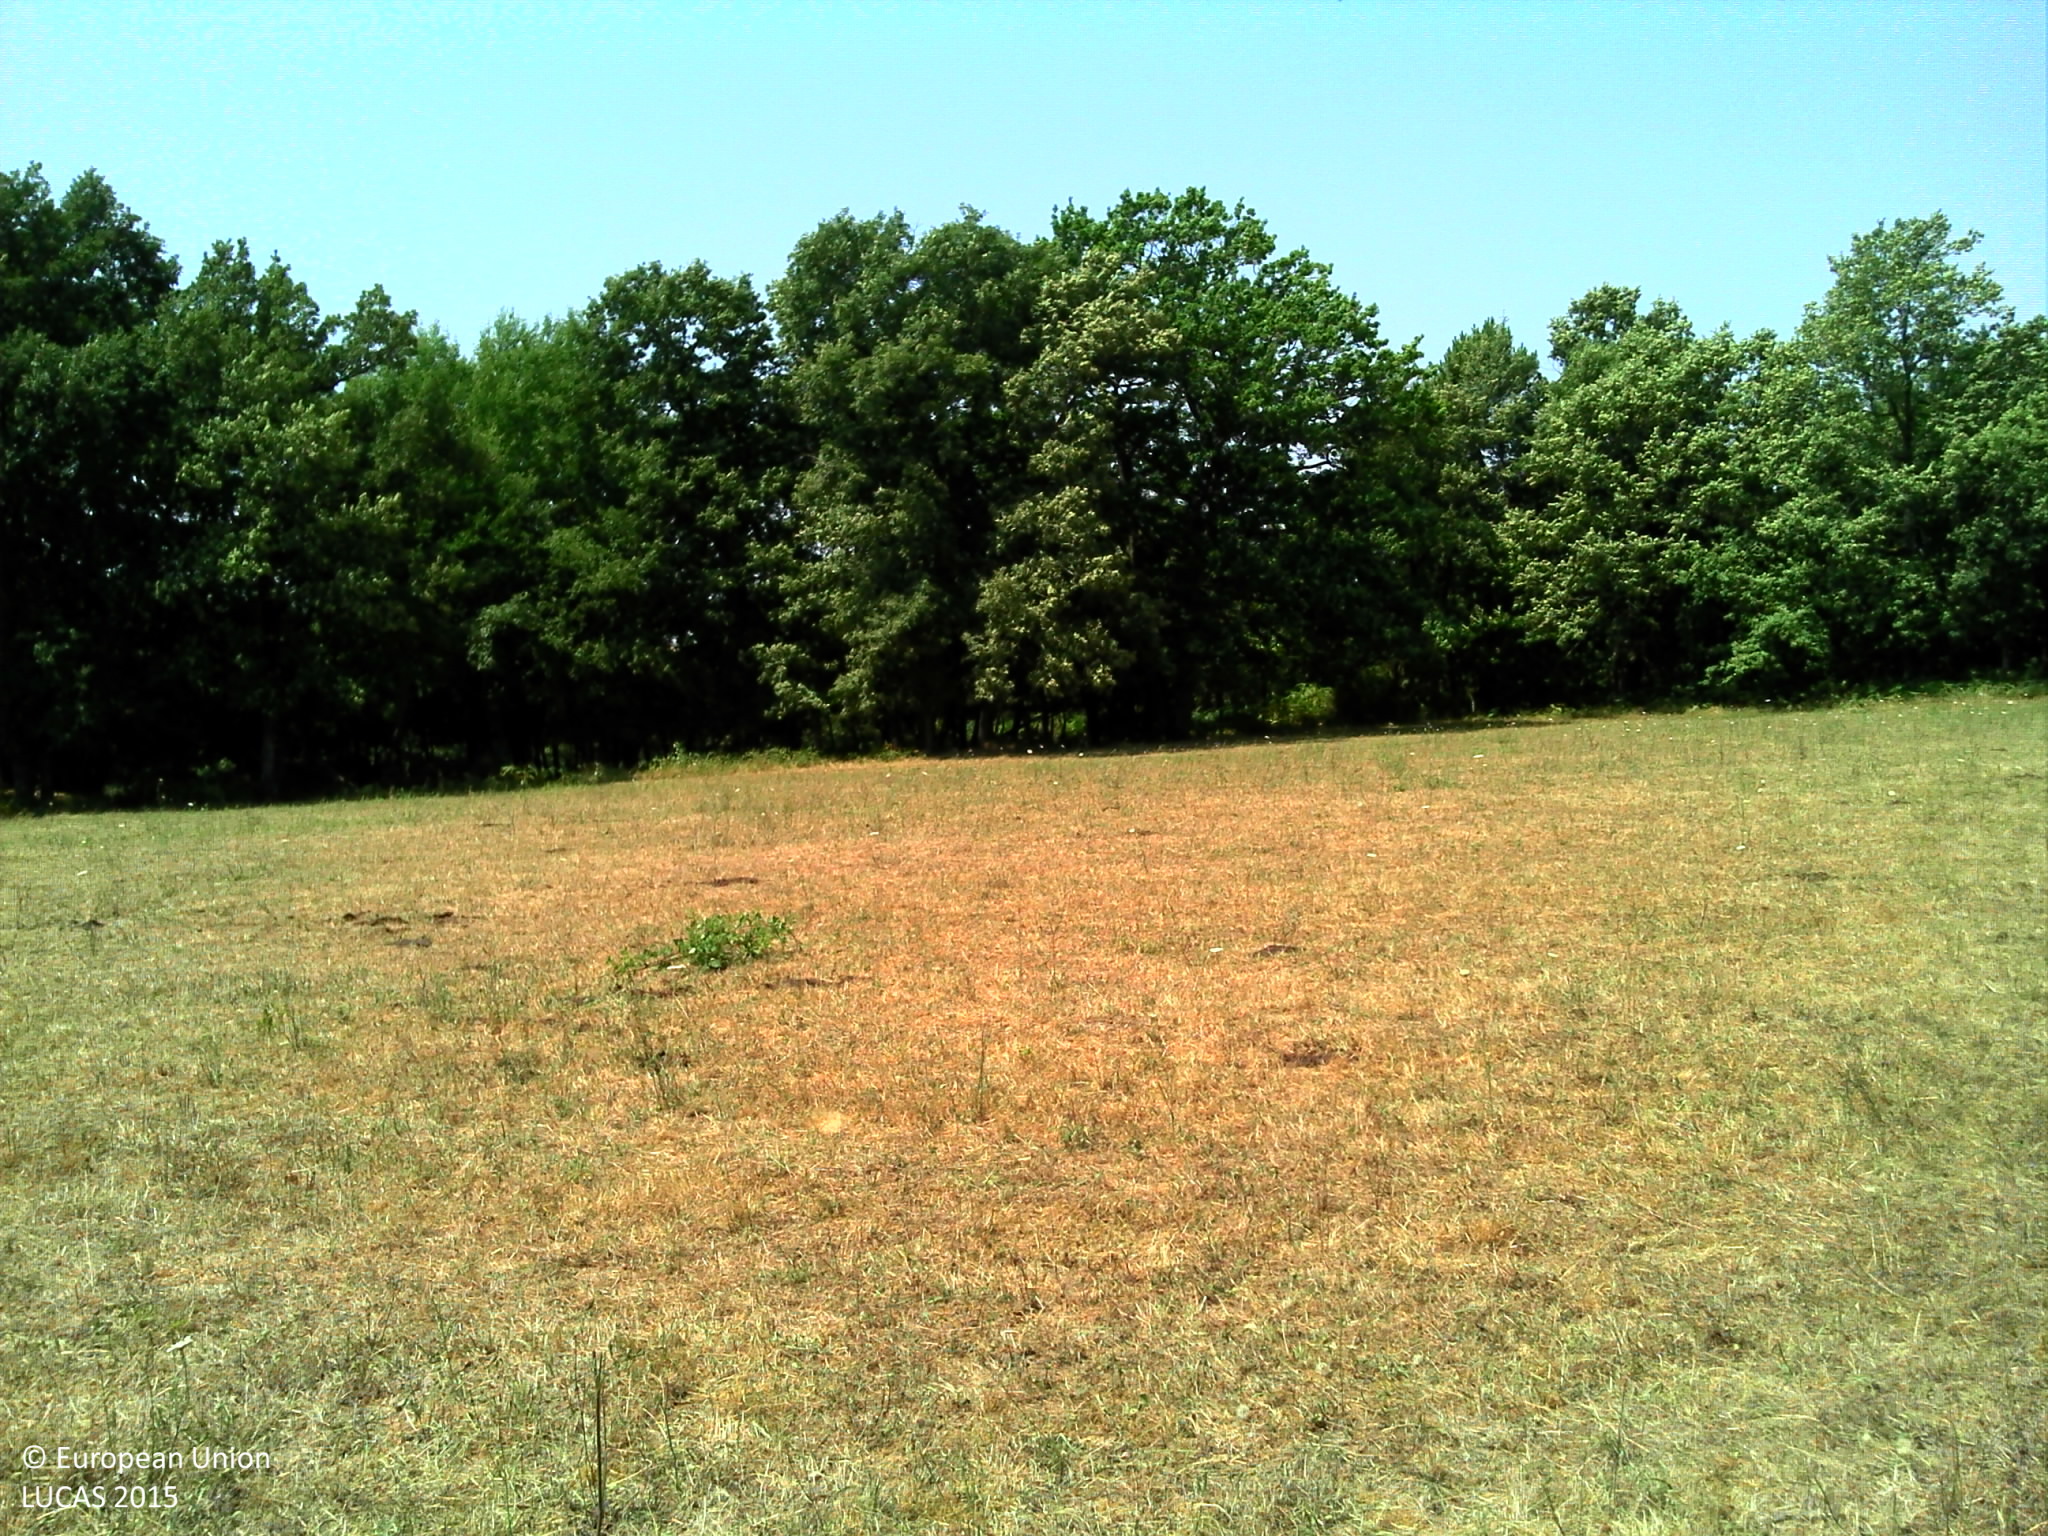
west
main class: Grassland
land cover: Grassland without tree/shrub cover
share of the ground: > 75 %
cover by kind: herbaceous plants 100 %
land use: Agriculture (excluding fallow land and kitchen gardens)
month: July
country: FR
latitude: 45.1179
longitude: 0.7747
